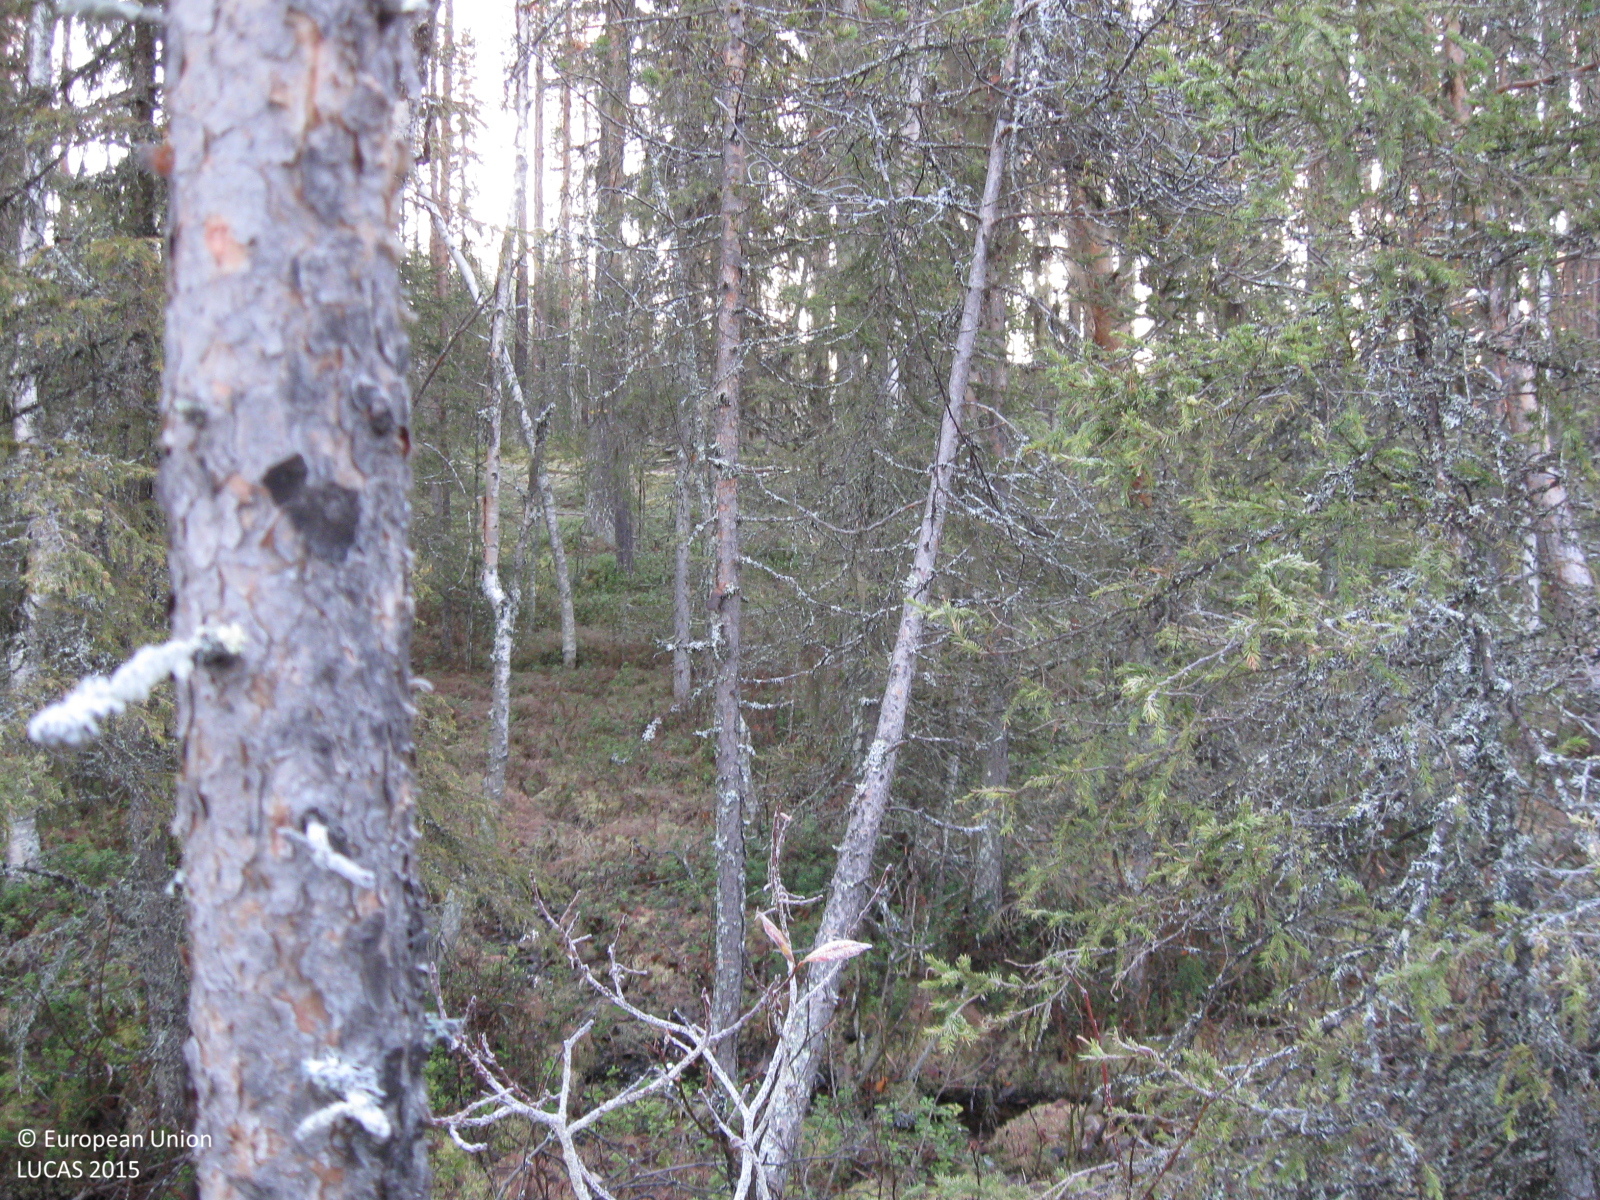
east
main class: Woodland
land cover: Pine dominated coniferous woodland
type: mire and swamp forests
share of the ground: 50 - 75 %
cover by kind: coniferous forest trees 60 %, broadleaved forest trees 10 %, shrubs 10 %, herbaceous plants 10 %, lichens and mosses 10 %
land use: Forestry
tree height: > 5 m
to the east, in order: Pine dominated coniferous woodland; Spruce dominated mixed woodland; Pine dominated coniferous woodland; Tracks; Pine dominated coniferous woodland; Spruce dominated mixed woodland; Pine dominated coniferous woodland; Pine dominated mixed woodland
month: October
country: SE
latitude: 66.4697
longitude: 20.9354
